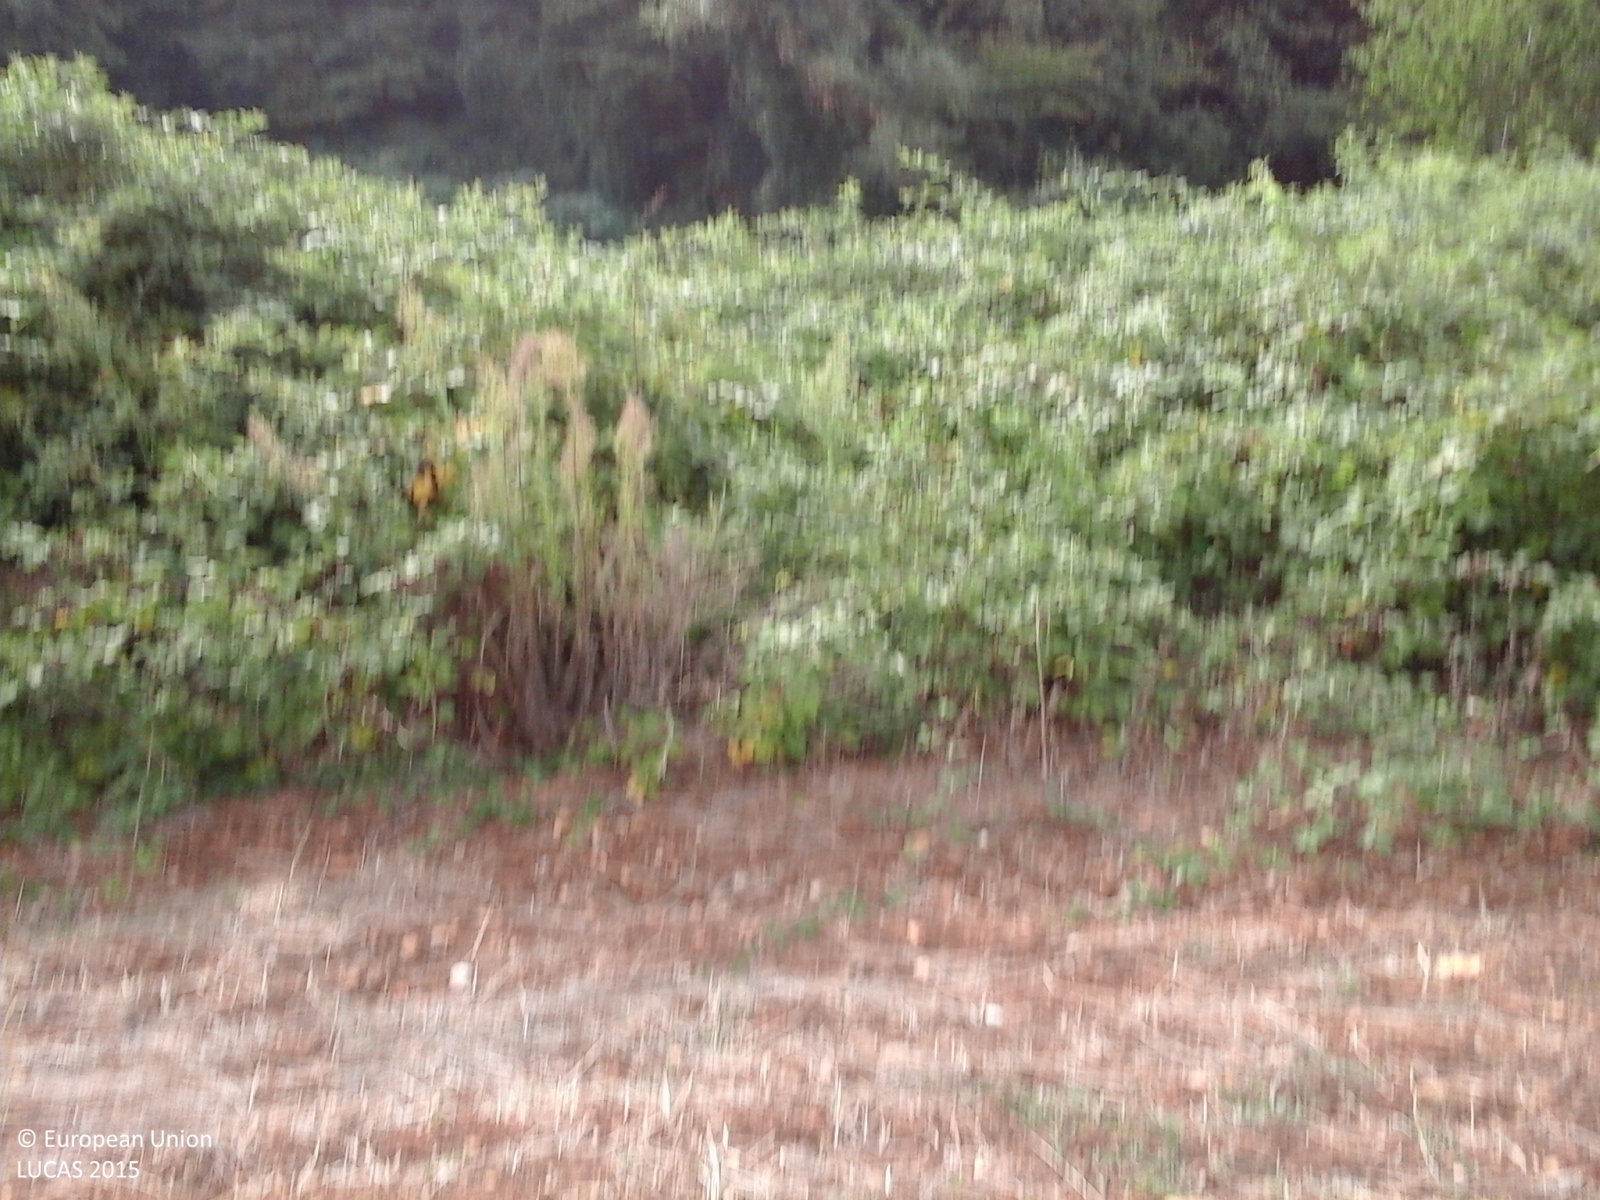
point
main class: Shrubland
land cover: Shrubland without tree cover
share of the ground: > 75 %
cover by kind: shrubs 95 %, herbaceous plants 5 %
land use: Semi-natural and natural areas not in use
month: September
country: IT
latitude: 41.8688
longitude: 15.2009
